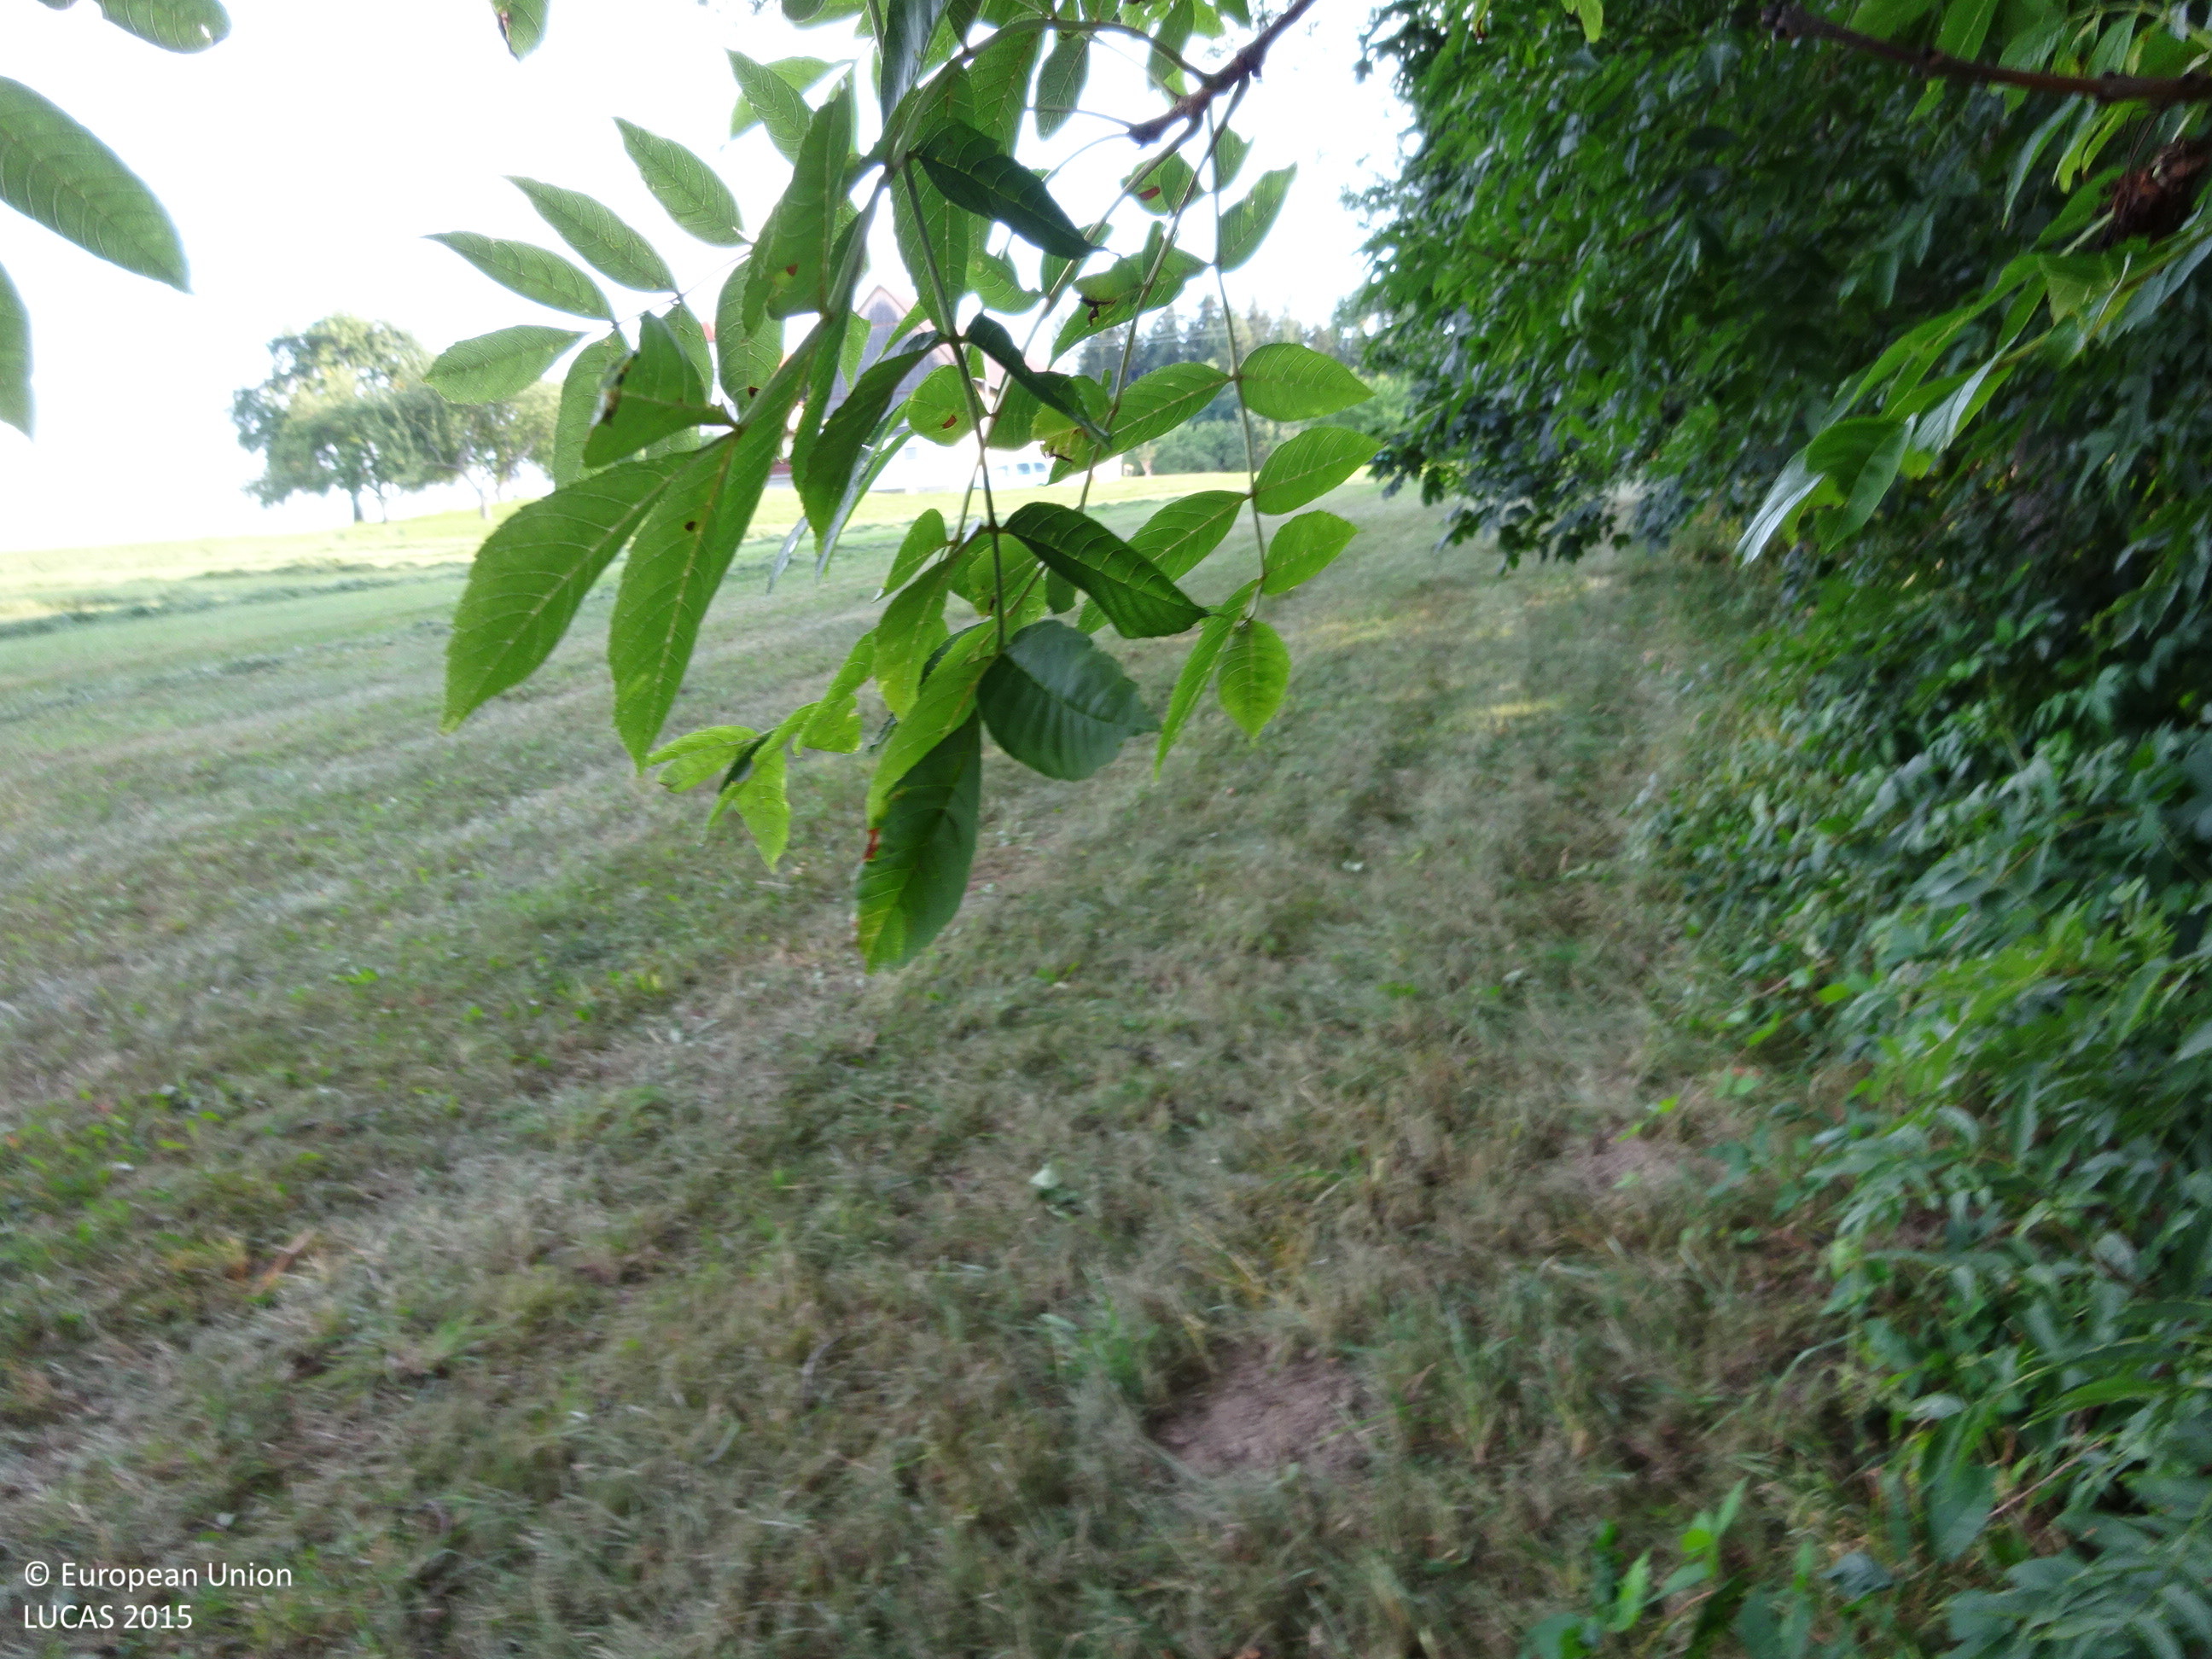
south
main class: Woodland
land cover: Broadleaved woodland
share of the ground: 50 - 75 %
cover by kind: broadleaved forest trees 50 %, herbaceous plants 50 %
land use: Semi-natural and natural areas not in use
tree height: > 5 m
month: August
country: AT
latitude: 47.4037
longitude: 15.7921
